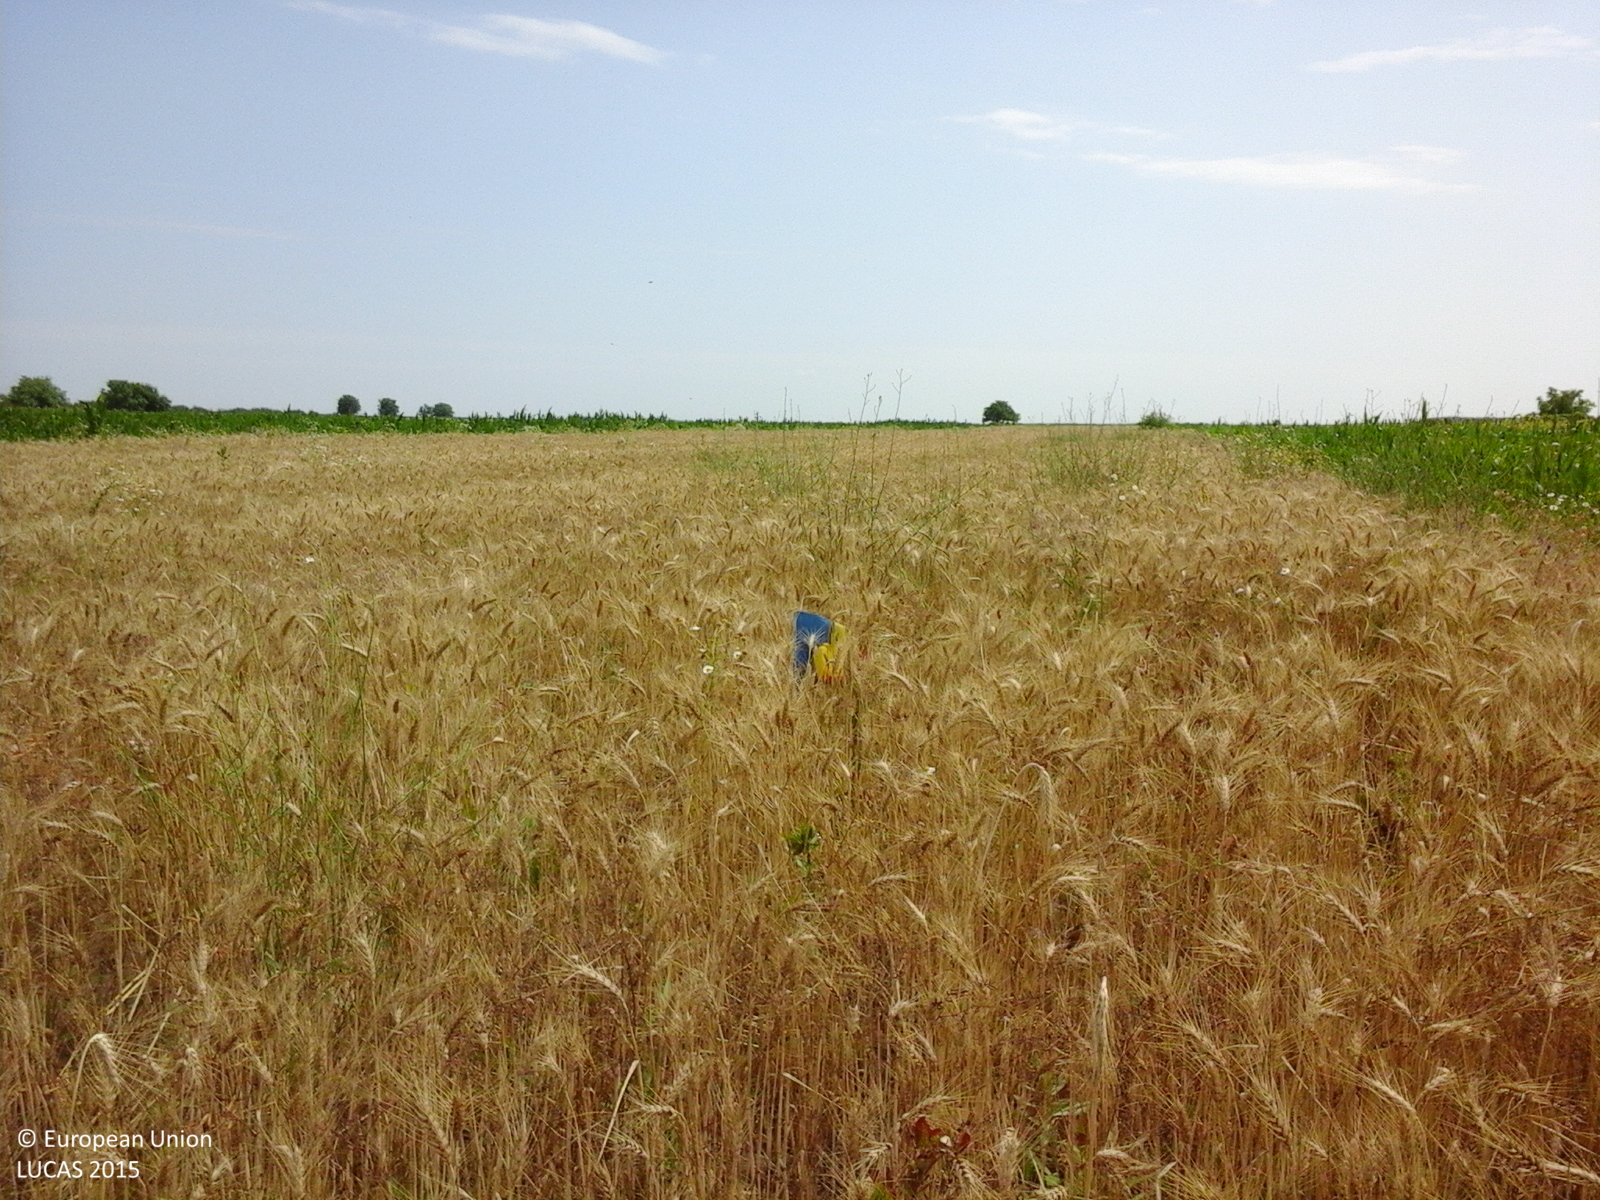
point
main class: Cropland
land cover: Common wheat
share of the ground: > 75 %
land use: Agriculture (excluding fallow land and kitchen gardens)
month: June
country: RO
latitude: 44.1595
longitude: 26.3772
